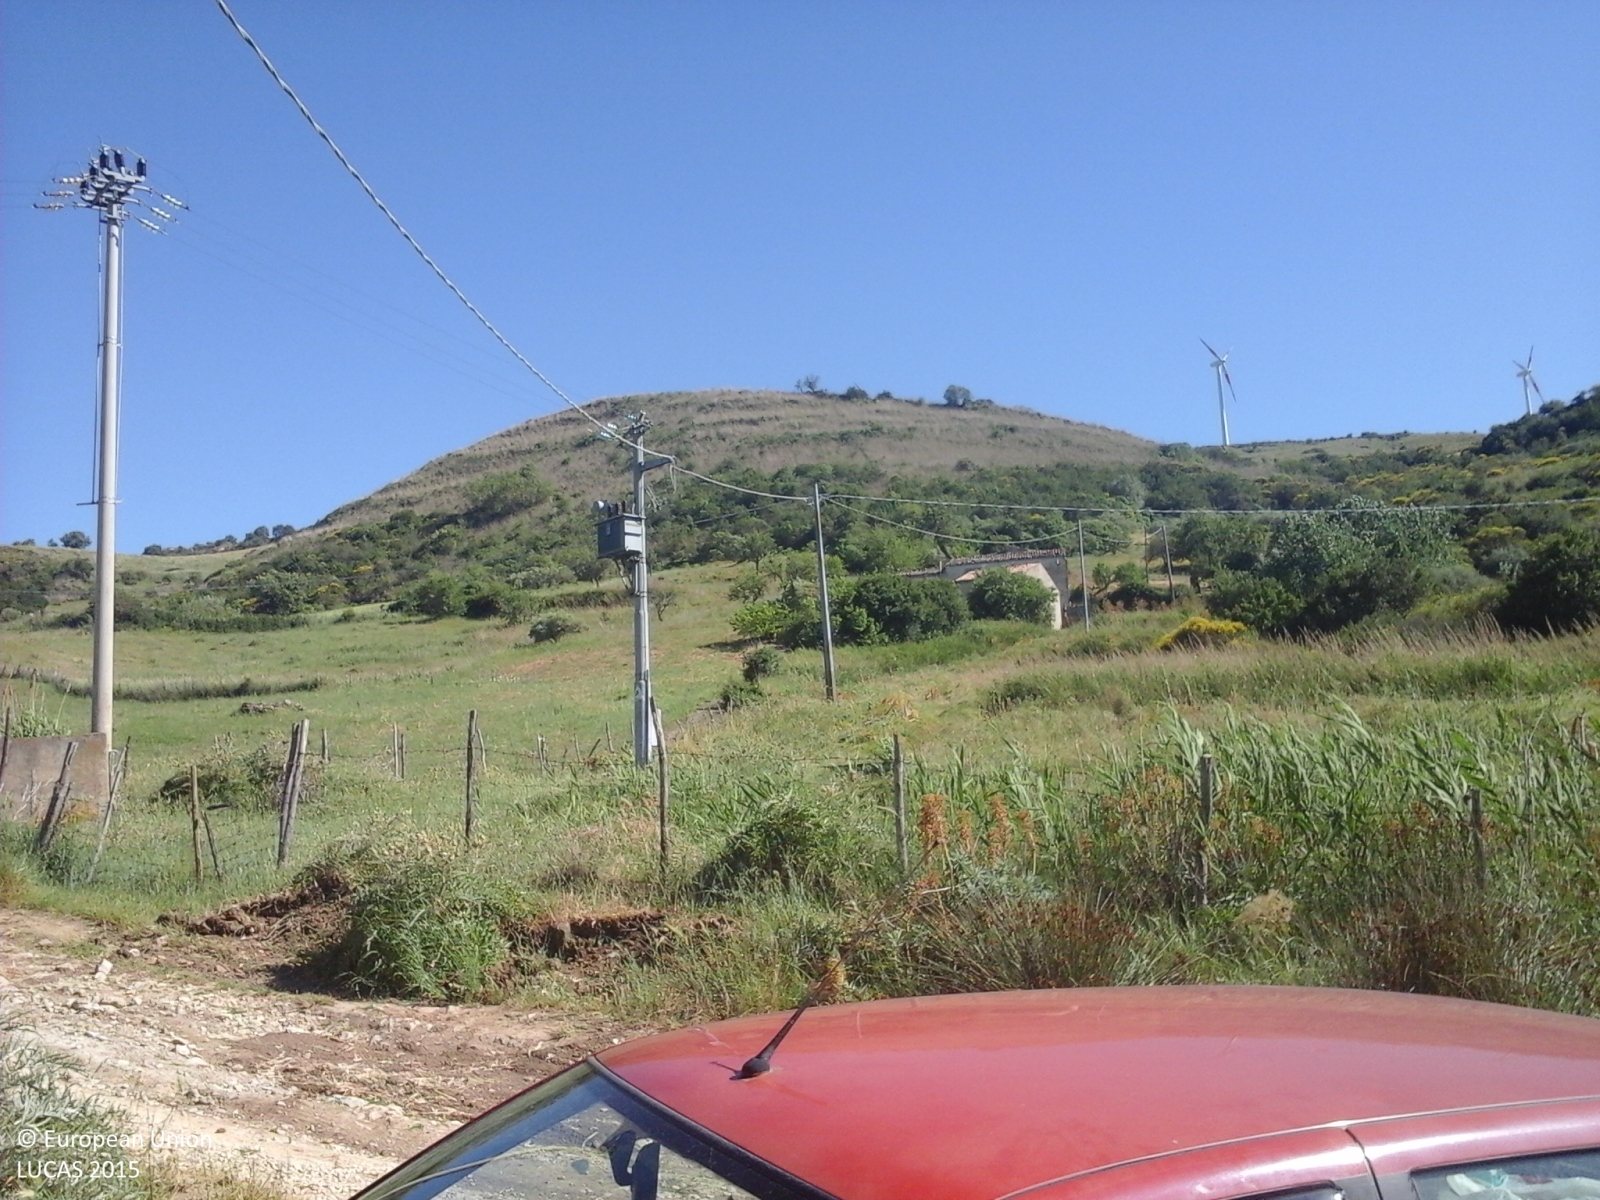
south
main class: Shrubland
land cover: Shrubland with sparse tree cover
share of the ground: > 75 %
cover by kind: herbaceous plants 55 %, shrubs 40 %, broadleaved forest trees 5 %
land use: Agriculture (excluding fallow land and kitchen gardens)
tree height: > 5 m
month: May
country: IT
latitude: 37.7171
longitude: 14.4268
